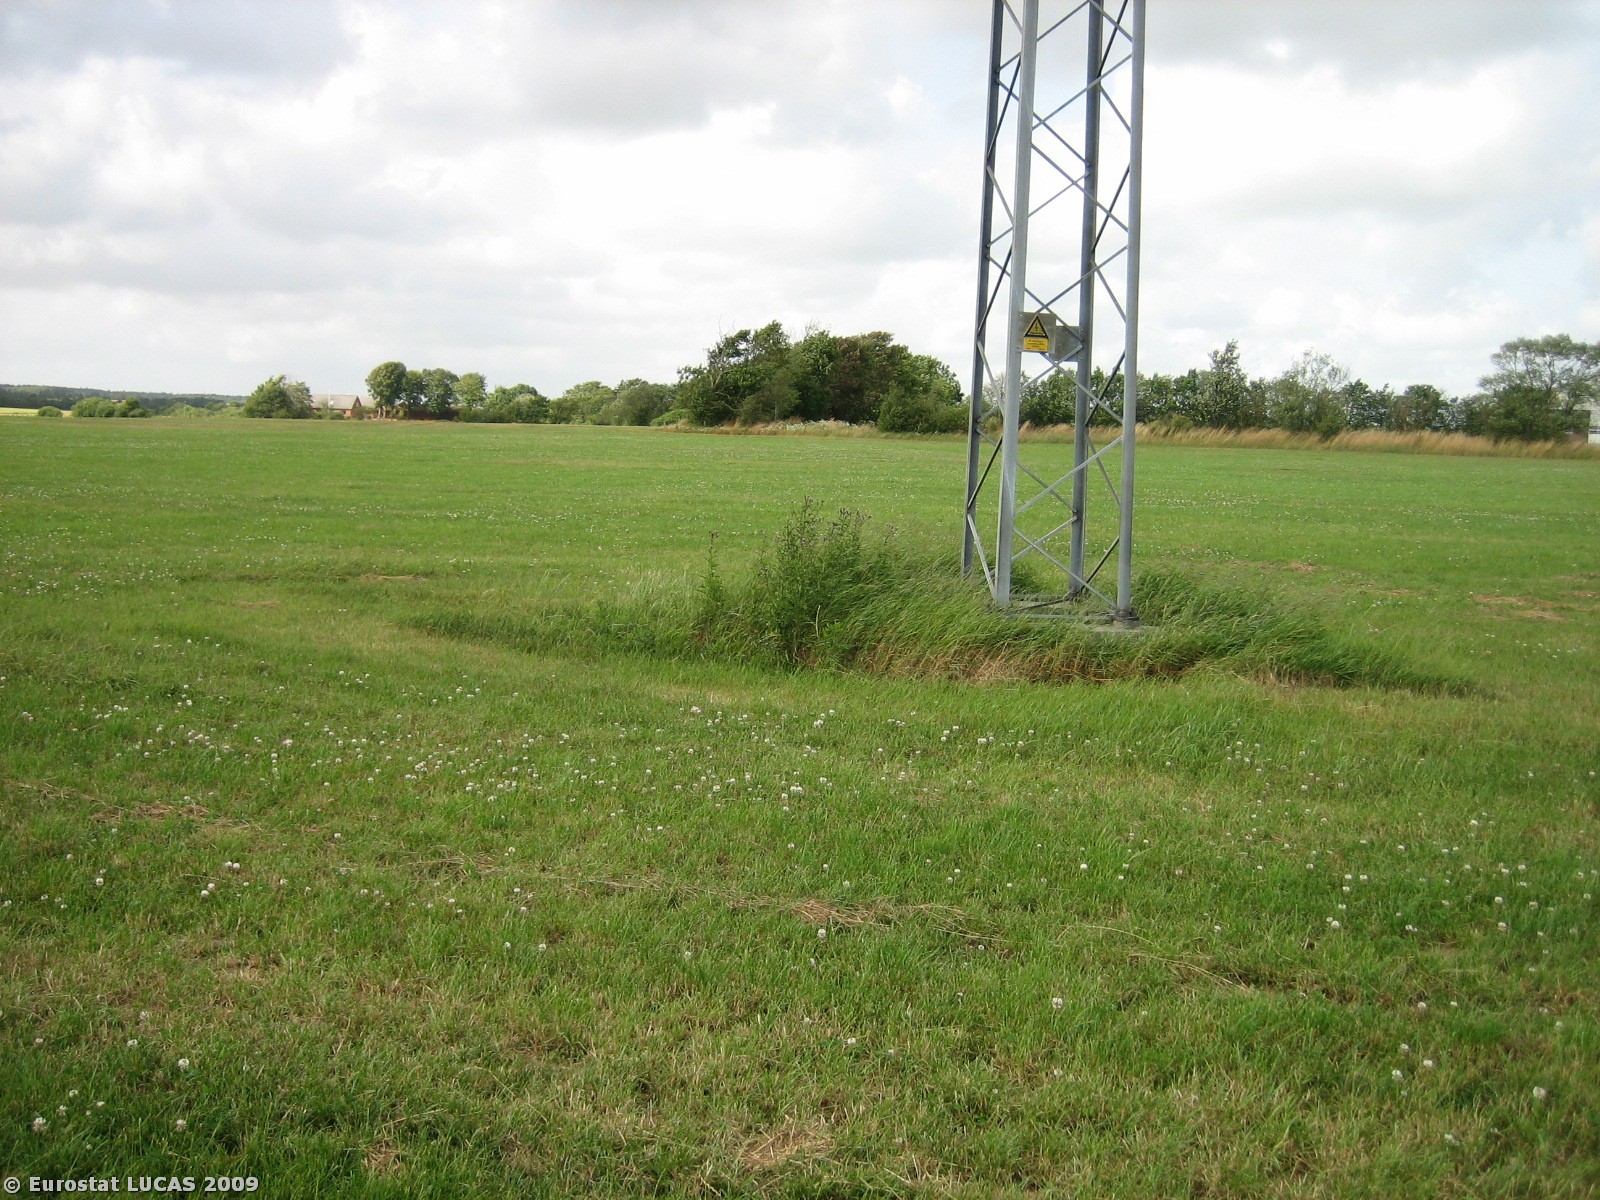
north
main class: Cropland
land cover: Temporary grasslands
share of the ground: > 75 %
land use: Agriculture (excluding fallow land and kitchen gardens)
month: July
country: DK
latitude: 55.7298
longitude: 8.5205
